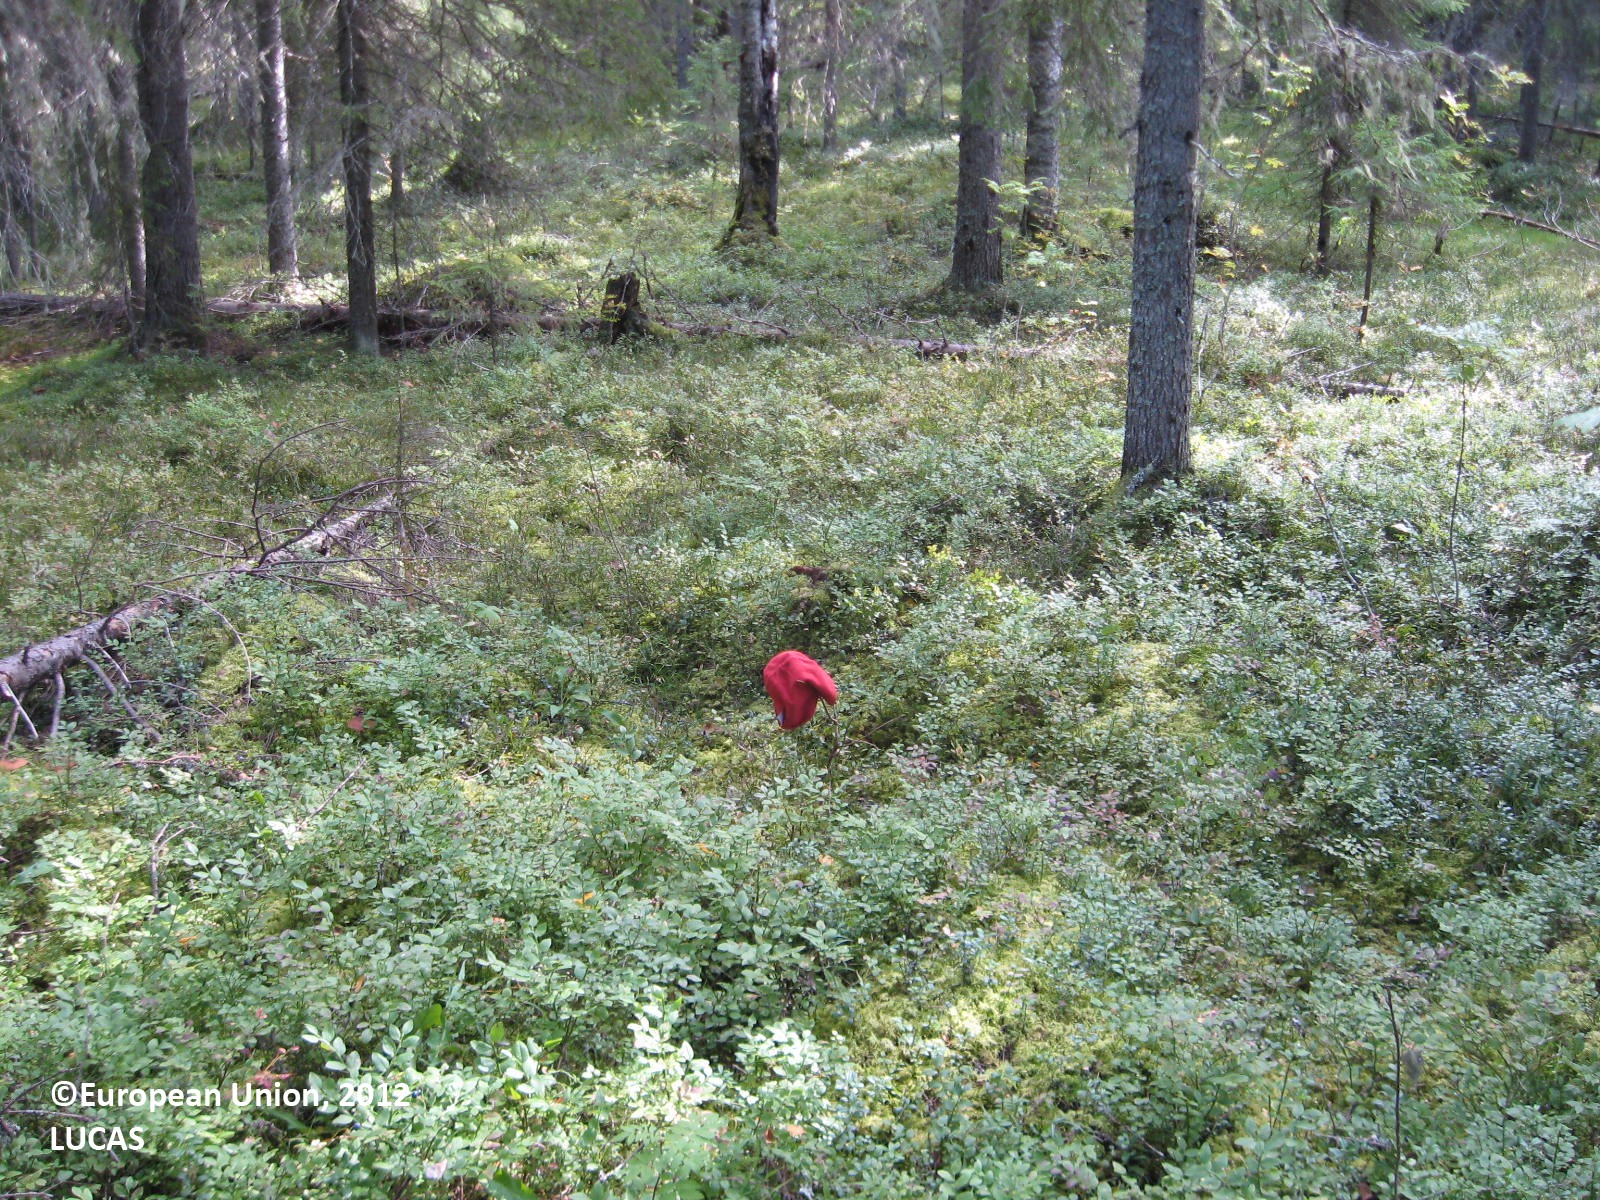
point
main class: Woodland
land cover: Spruce dominated coniferous woodland
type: boreal forest
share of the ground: > 75 %
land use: Forestry
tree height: > 5 m
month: August
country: FI
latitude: 63.8001
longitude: 29.8270
